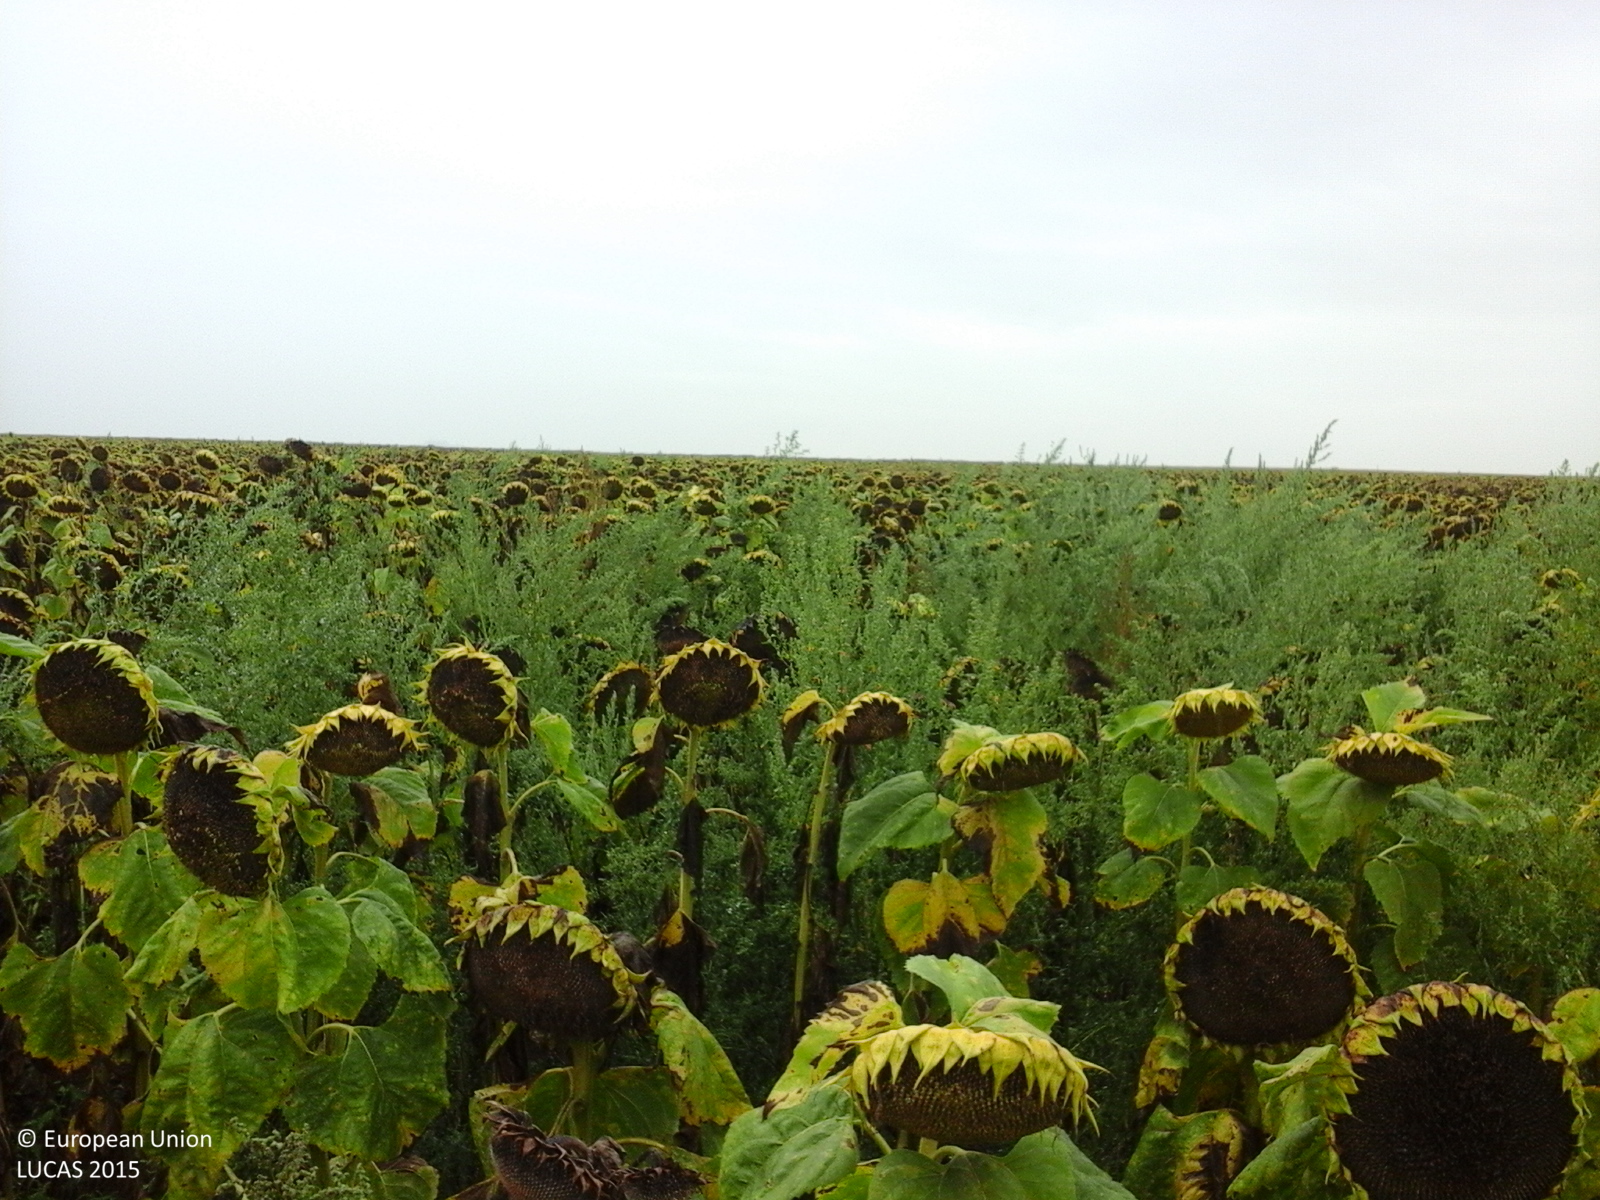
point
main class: Cropland
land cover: Sunflower
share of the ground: > 75 %
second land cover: Spontaneously vegetated surfaces
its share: 25 - 50 %
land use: Agriculture (excluding fallow land and kitchen gardens)
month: August
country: RO
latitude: 45.5864
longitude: 20.9598
